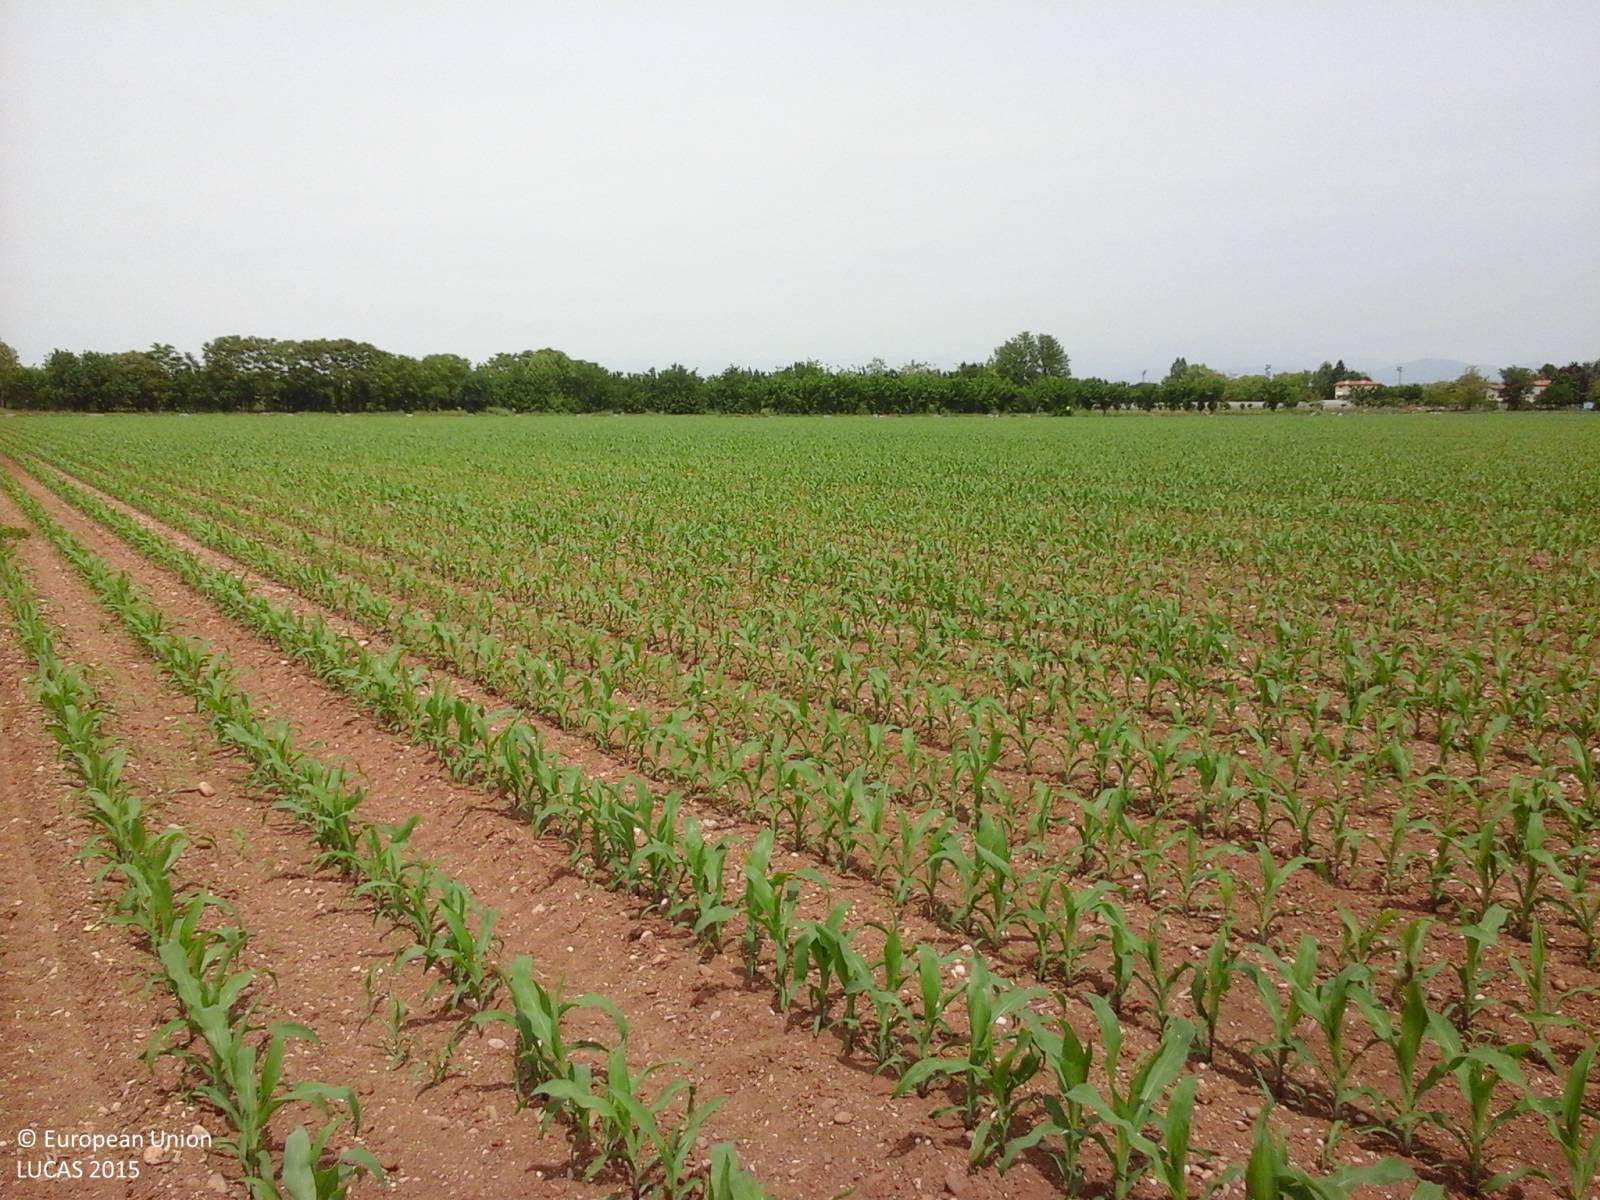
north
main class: Cropland
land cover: Maize
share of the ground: 25 - 50 %
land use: Agriculture (excluding fallow land and kitchen gardens)
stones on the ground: 10 - 25 %
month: May
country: IT
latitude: 45.9066
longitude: 13.2060
